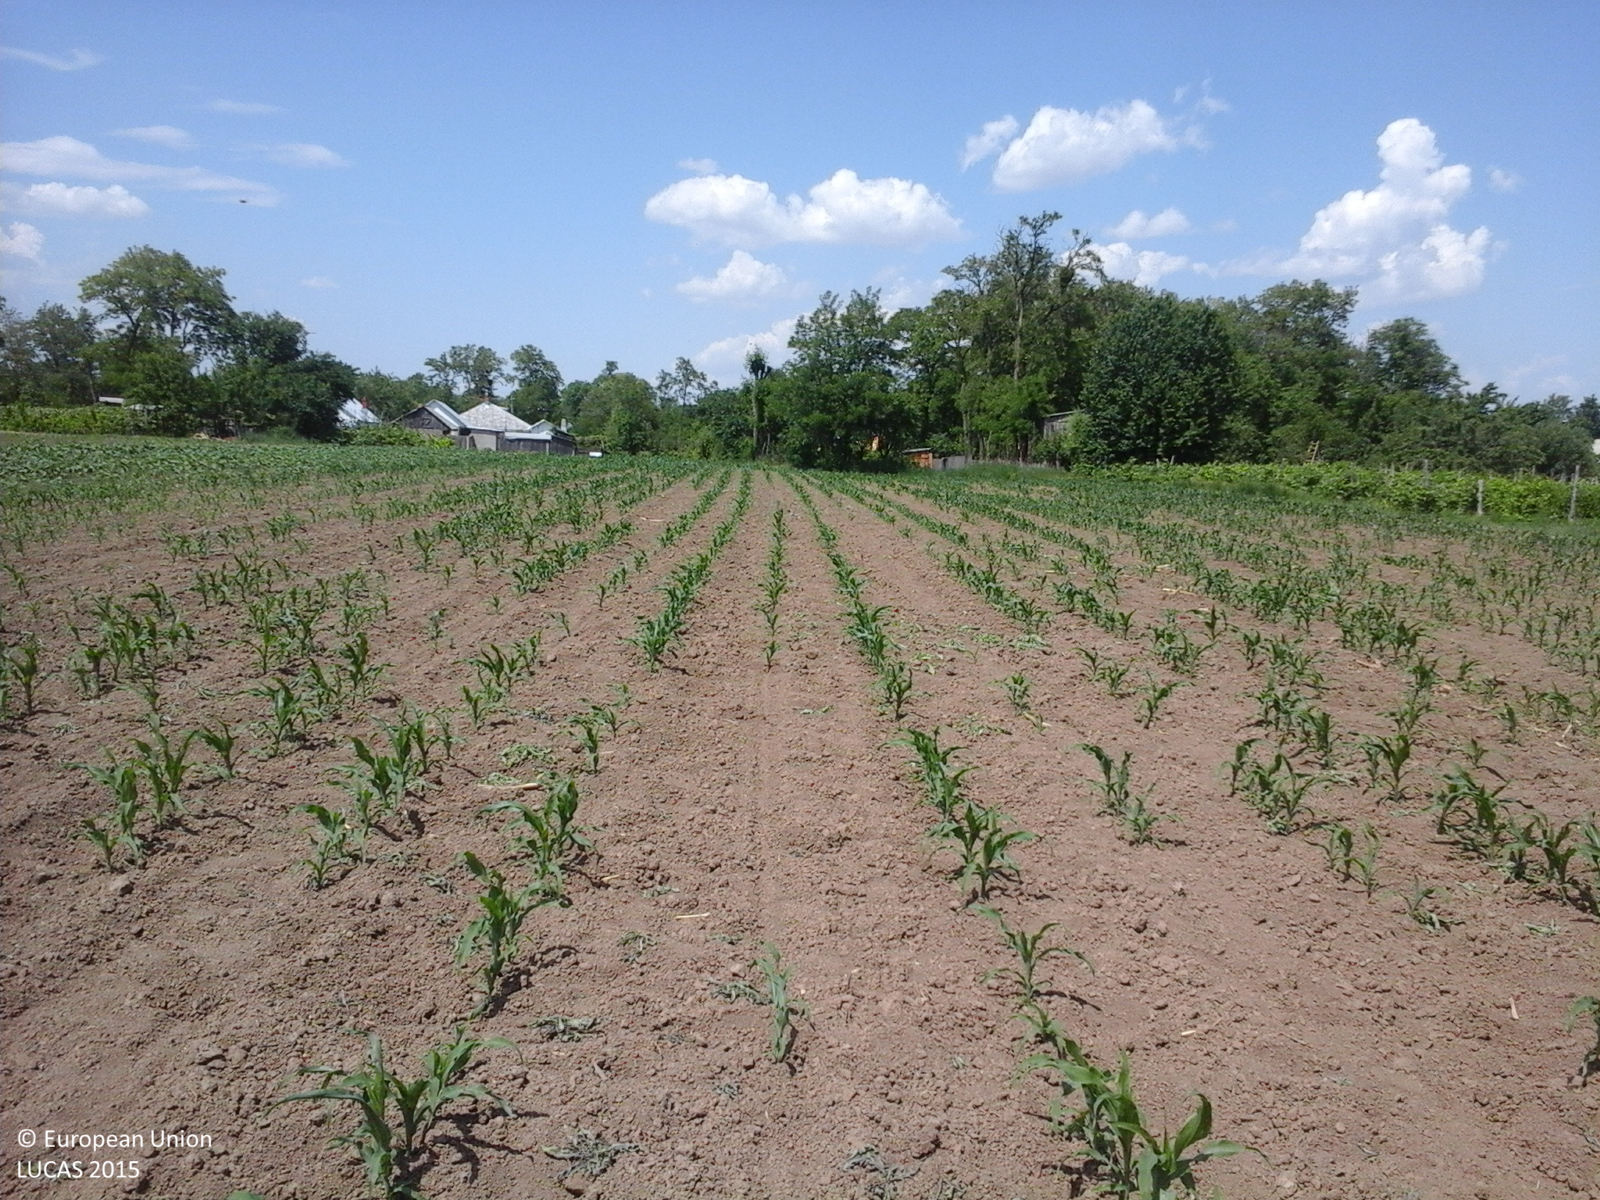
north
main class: Cropland
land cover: Maize
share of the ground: 10 - 25 %
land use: Agriculture (excluding fallow land and kitchen gardens)
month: June
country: RO
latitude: 46.7938
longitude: 26.7960
